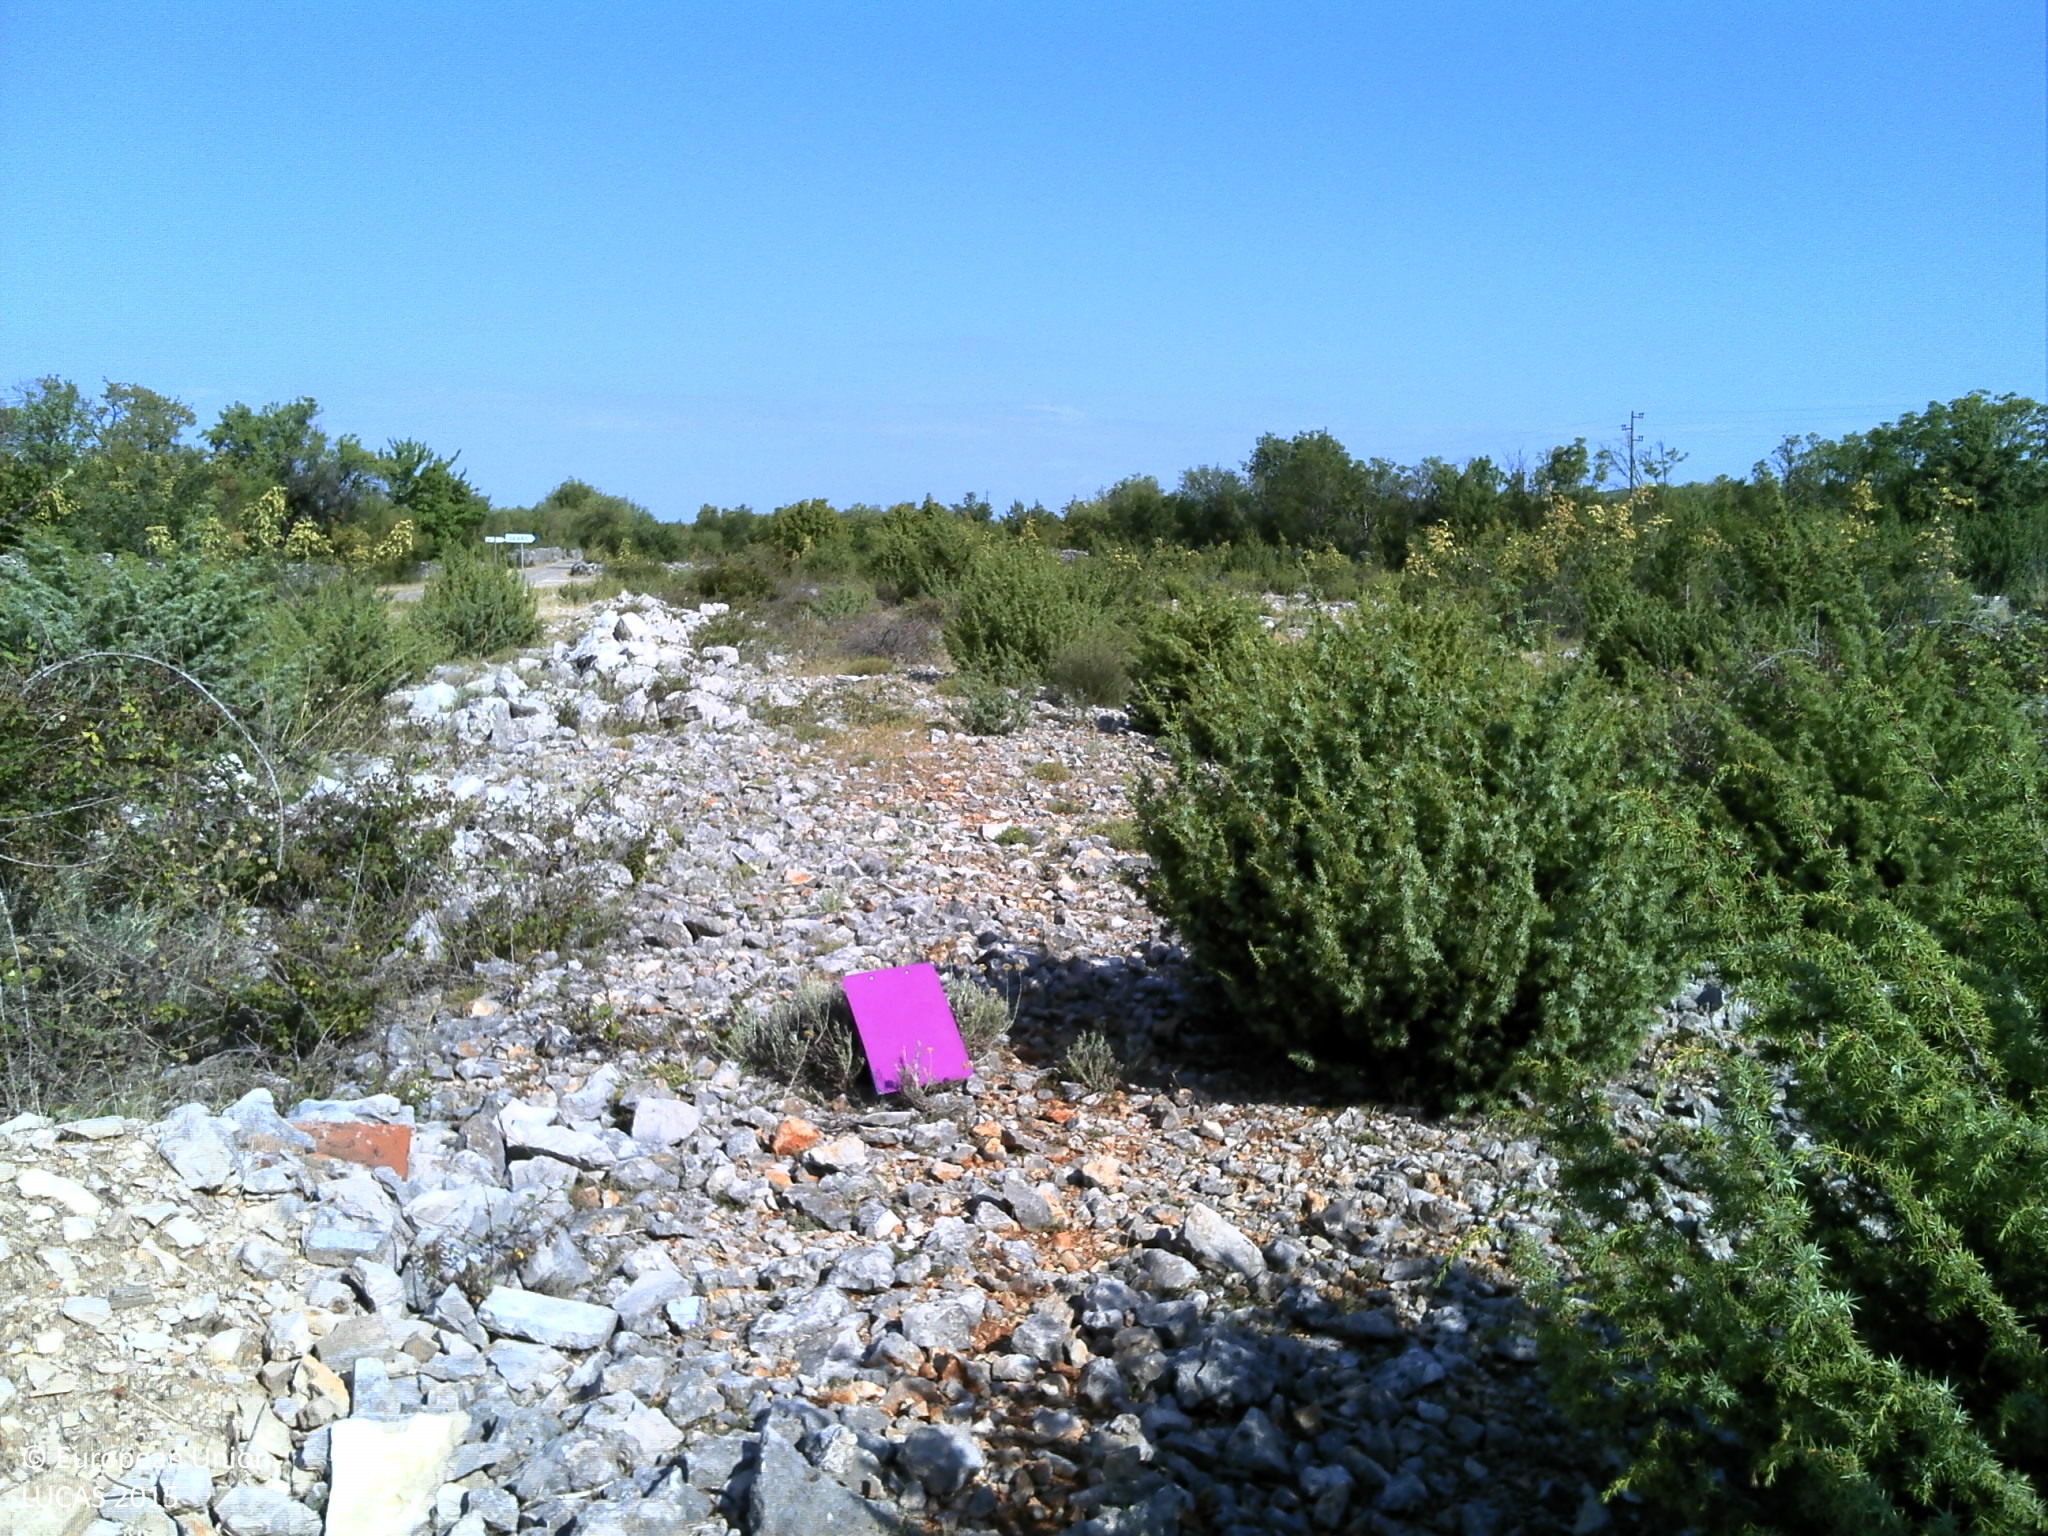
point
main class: Shrubland
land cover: Shrubland without tree cover
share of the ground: 25 - 50 %
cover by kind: unconsolidated bare surface 45 %, shrubs 30 %, herbaceous plants 15 %, consolidated bare surface 10 %
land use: Semi-natural and natural areas not in use
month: July
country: HR
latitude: 43.7737
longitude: 16.0914
